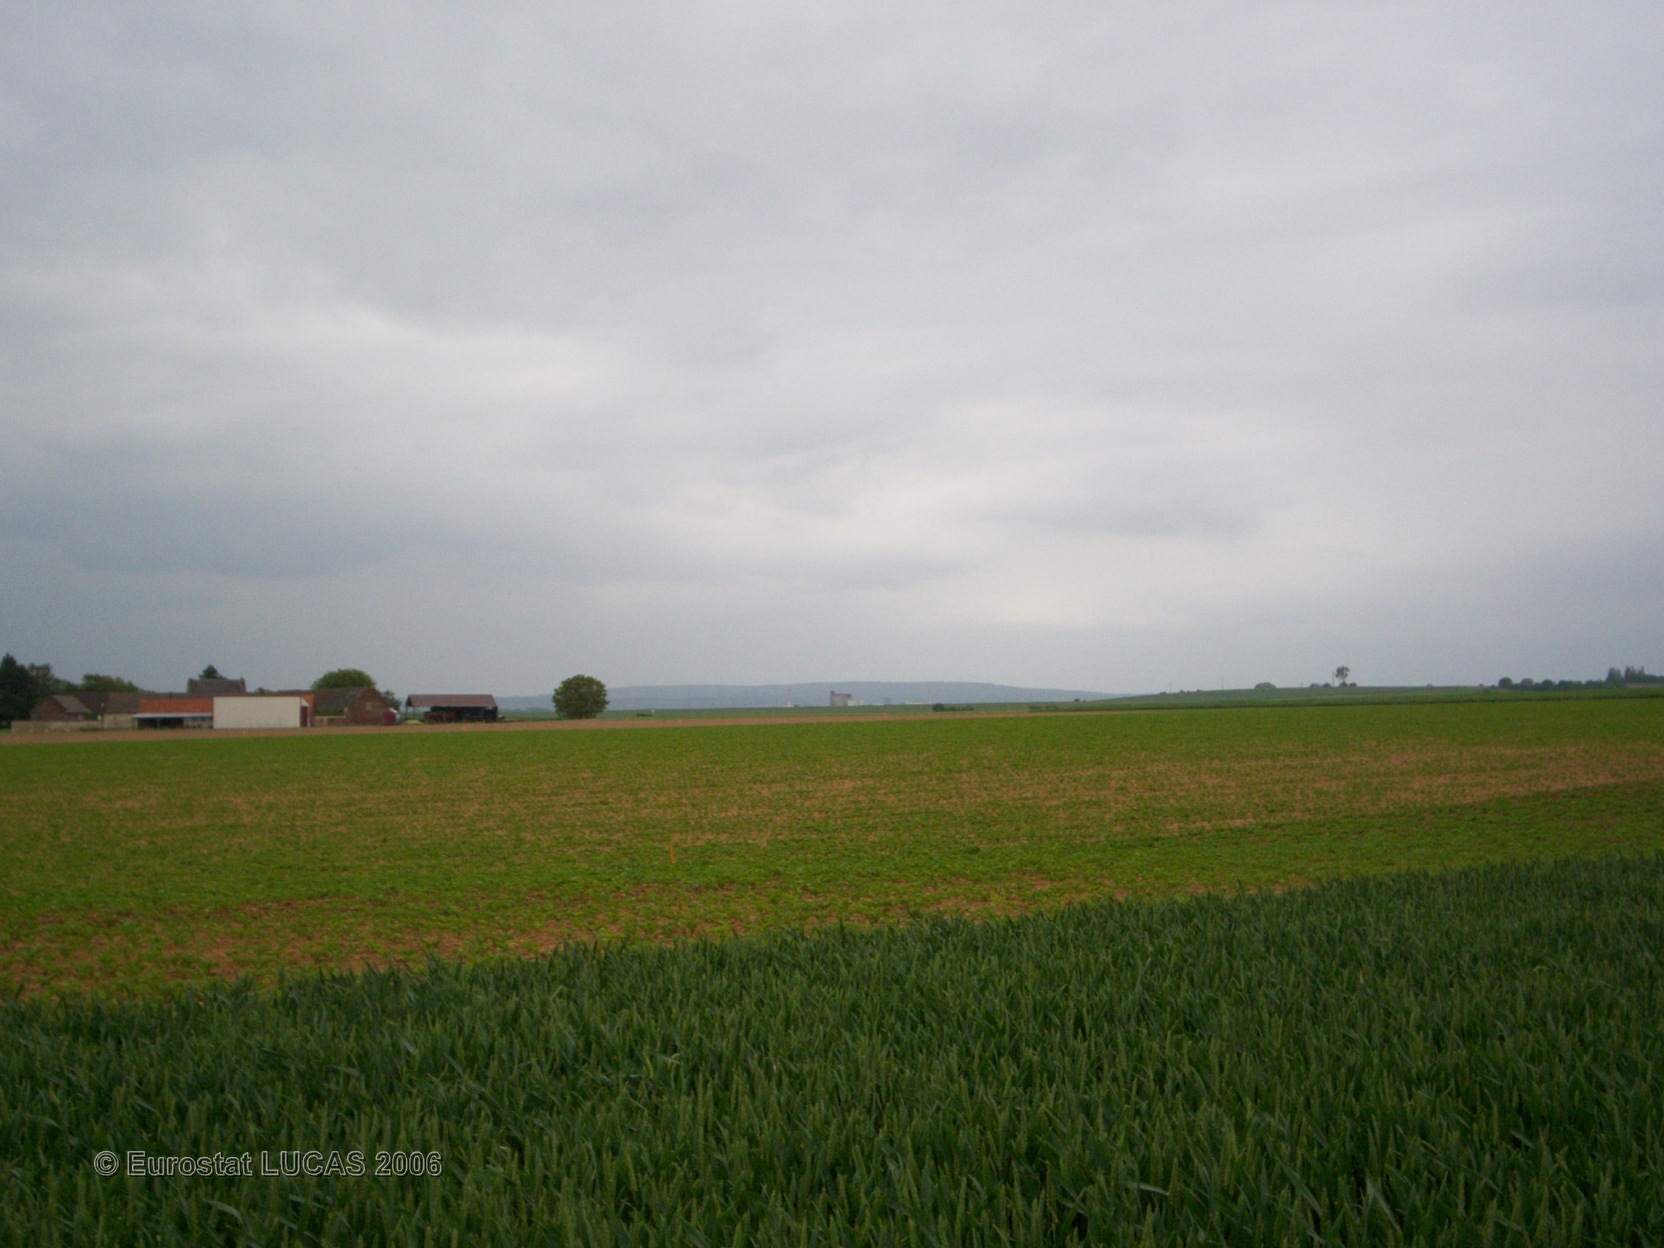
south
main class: Cropland
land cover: Common wheat
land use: Agriculture (excluding fallow land and kitchen gardens)
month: June
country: FR
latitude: 49.3886
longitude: 2.6736
